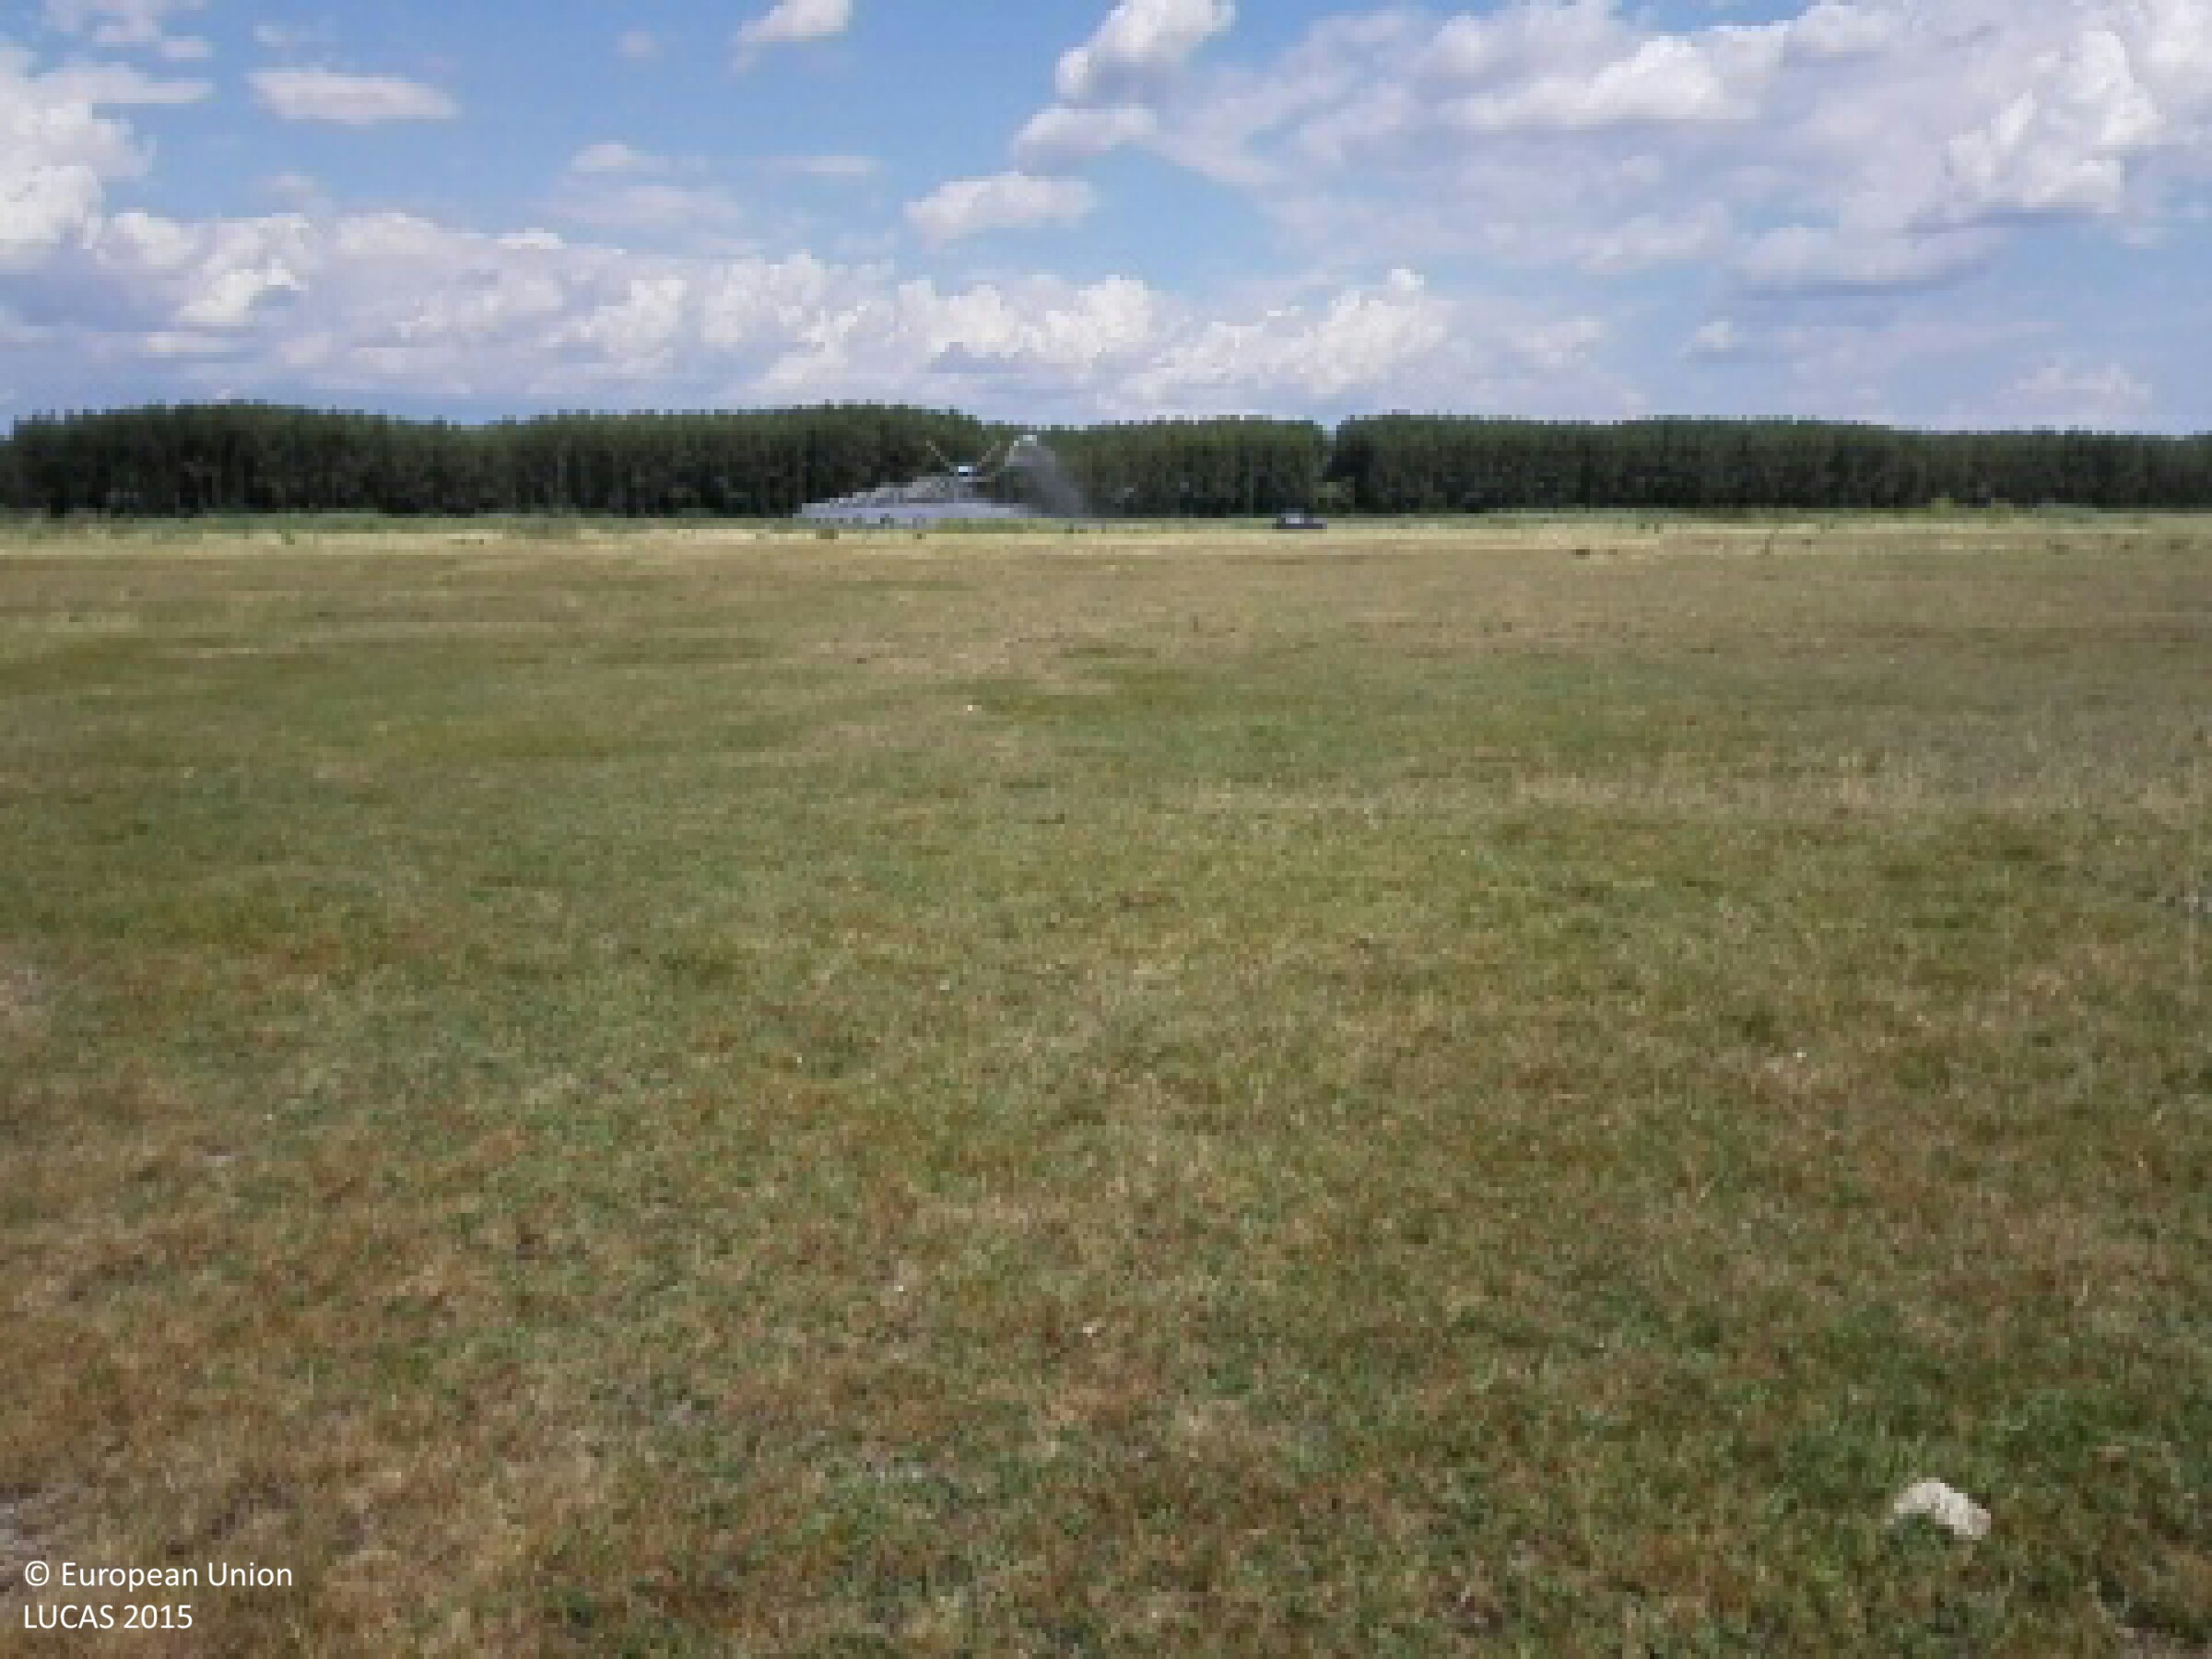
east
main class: Grassland
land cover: Grassland without tree/shrub cover
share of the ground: > 75 %
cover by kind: herbaceous plants 100 %
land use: Agriculture (excluding fallow land and kitchen gardens)
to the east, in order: Grassland without tree/shrub cover; Ditches and canals; Maize
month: July
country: HU
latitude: 47.5119
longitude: 21.3137
